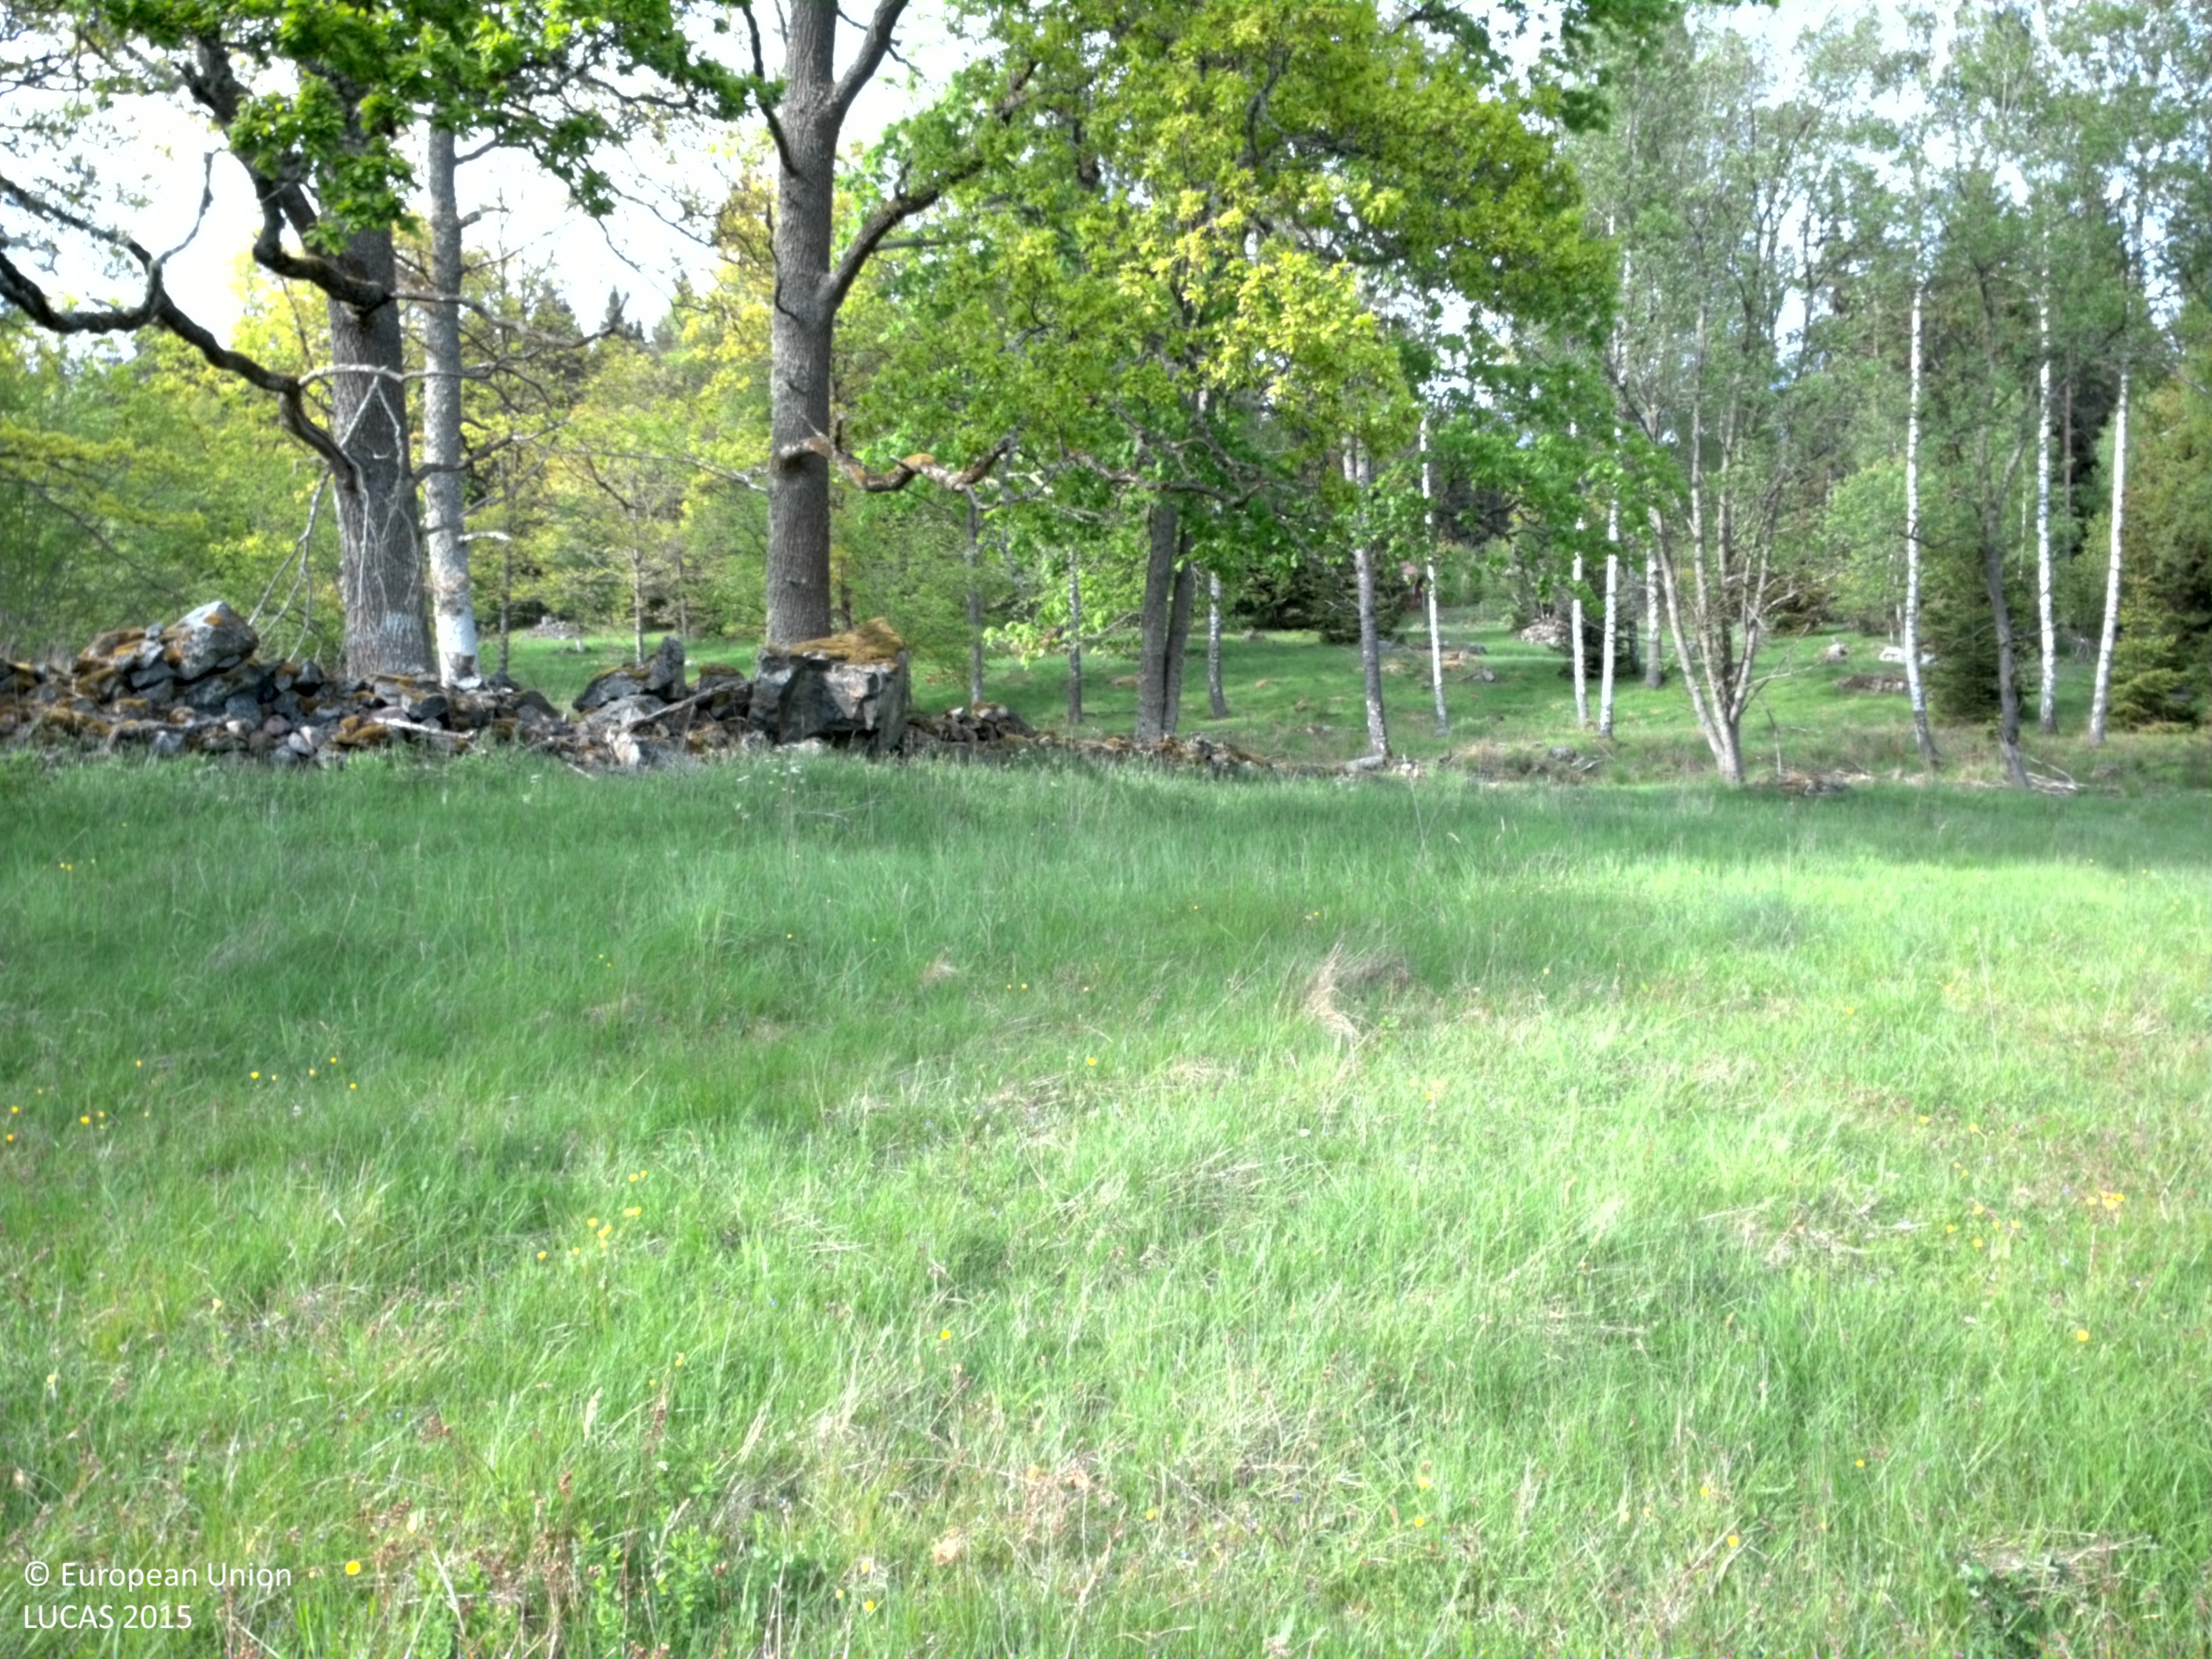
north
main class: Grassland
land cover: Grassland without tree/shrub cover
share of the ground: > 75 %
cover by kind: herbaceous plants 100 %
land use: Agriculture (excluding fallow land and kitchen gardens)
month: May
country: SE
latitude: 57.4269
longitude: 15.3760
